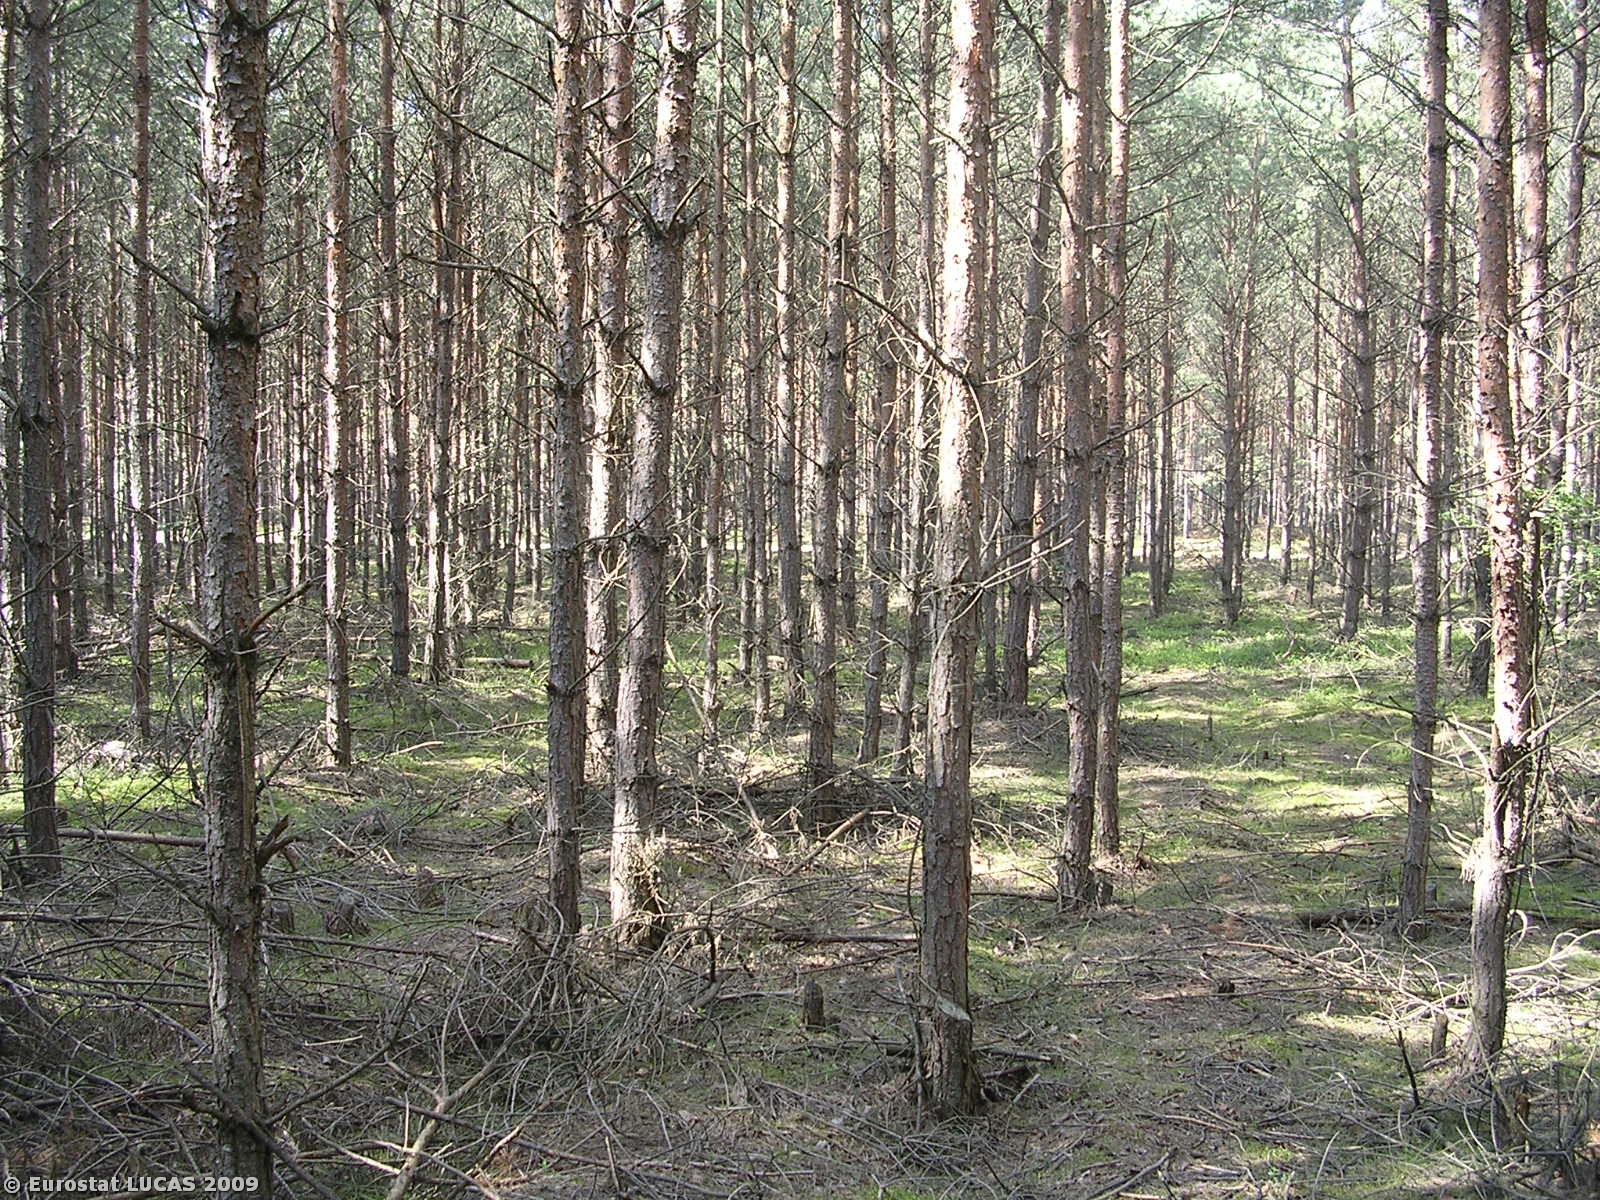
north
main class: Woodland
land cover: Coniferous woodland
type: hemiboreal forest and nemoral coniferous forest and mixed broadleaved-coniferous forest
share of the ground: > 75 %
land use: Forestry
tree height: > 5 m
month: June
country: CZ
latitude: 50.6296
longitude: 14.6532
